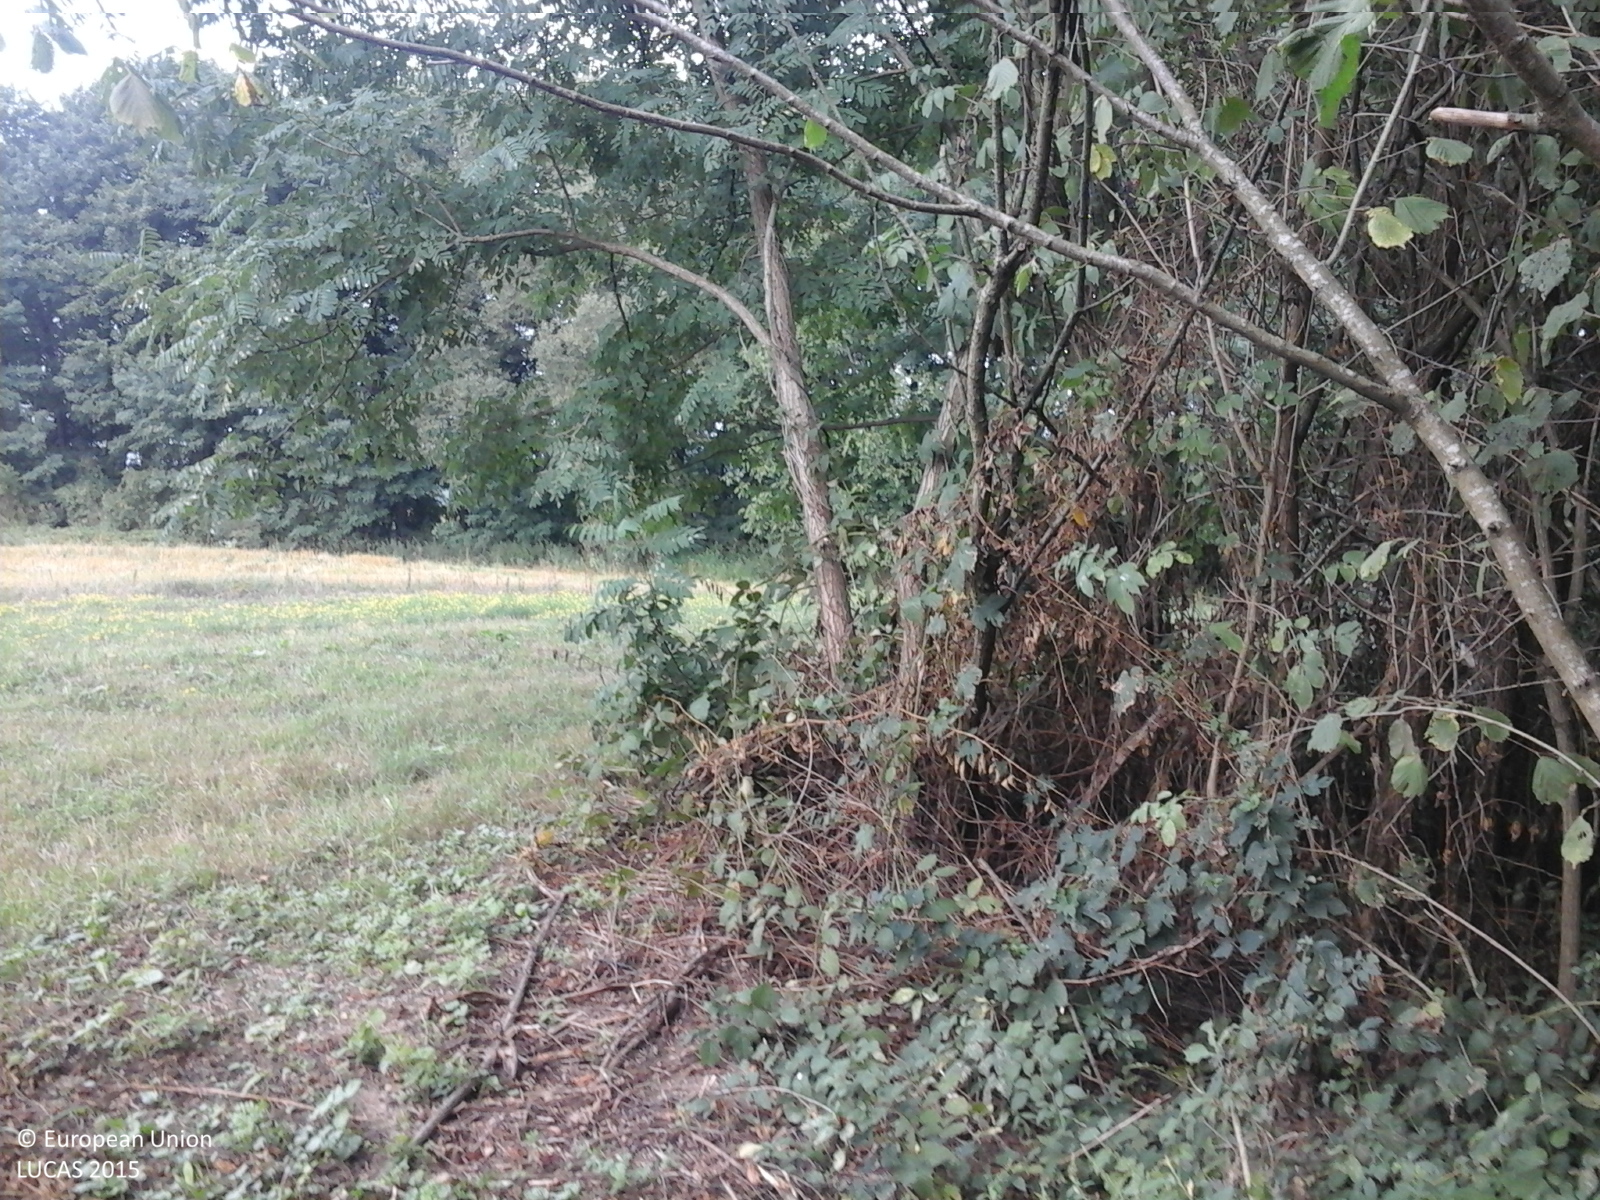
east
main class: Woodland
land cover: Broadleaved woodland
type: non-riverine alder, birch or aspen forest
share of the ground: > 75 %
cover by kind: broadleaved forest trees 100 %
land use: Forestry
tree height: > 5 m
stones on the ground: < 10 %
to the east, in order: Broadleaved woodland; Lucerne; Broadleaved woodland; Rivers and streams; Broadleaved woodland; Tracks; Lucerne; Maize; Spontaneously vegetated surfaces; Lucerne
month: August
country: RO
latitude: 46.2626
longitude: 22.2550
